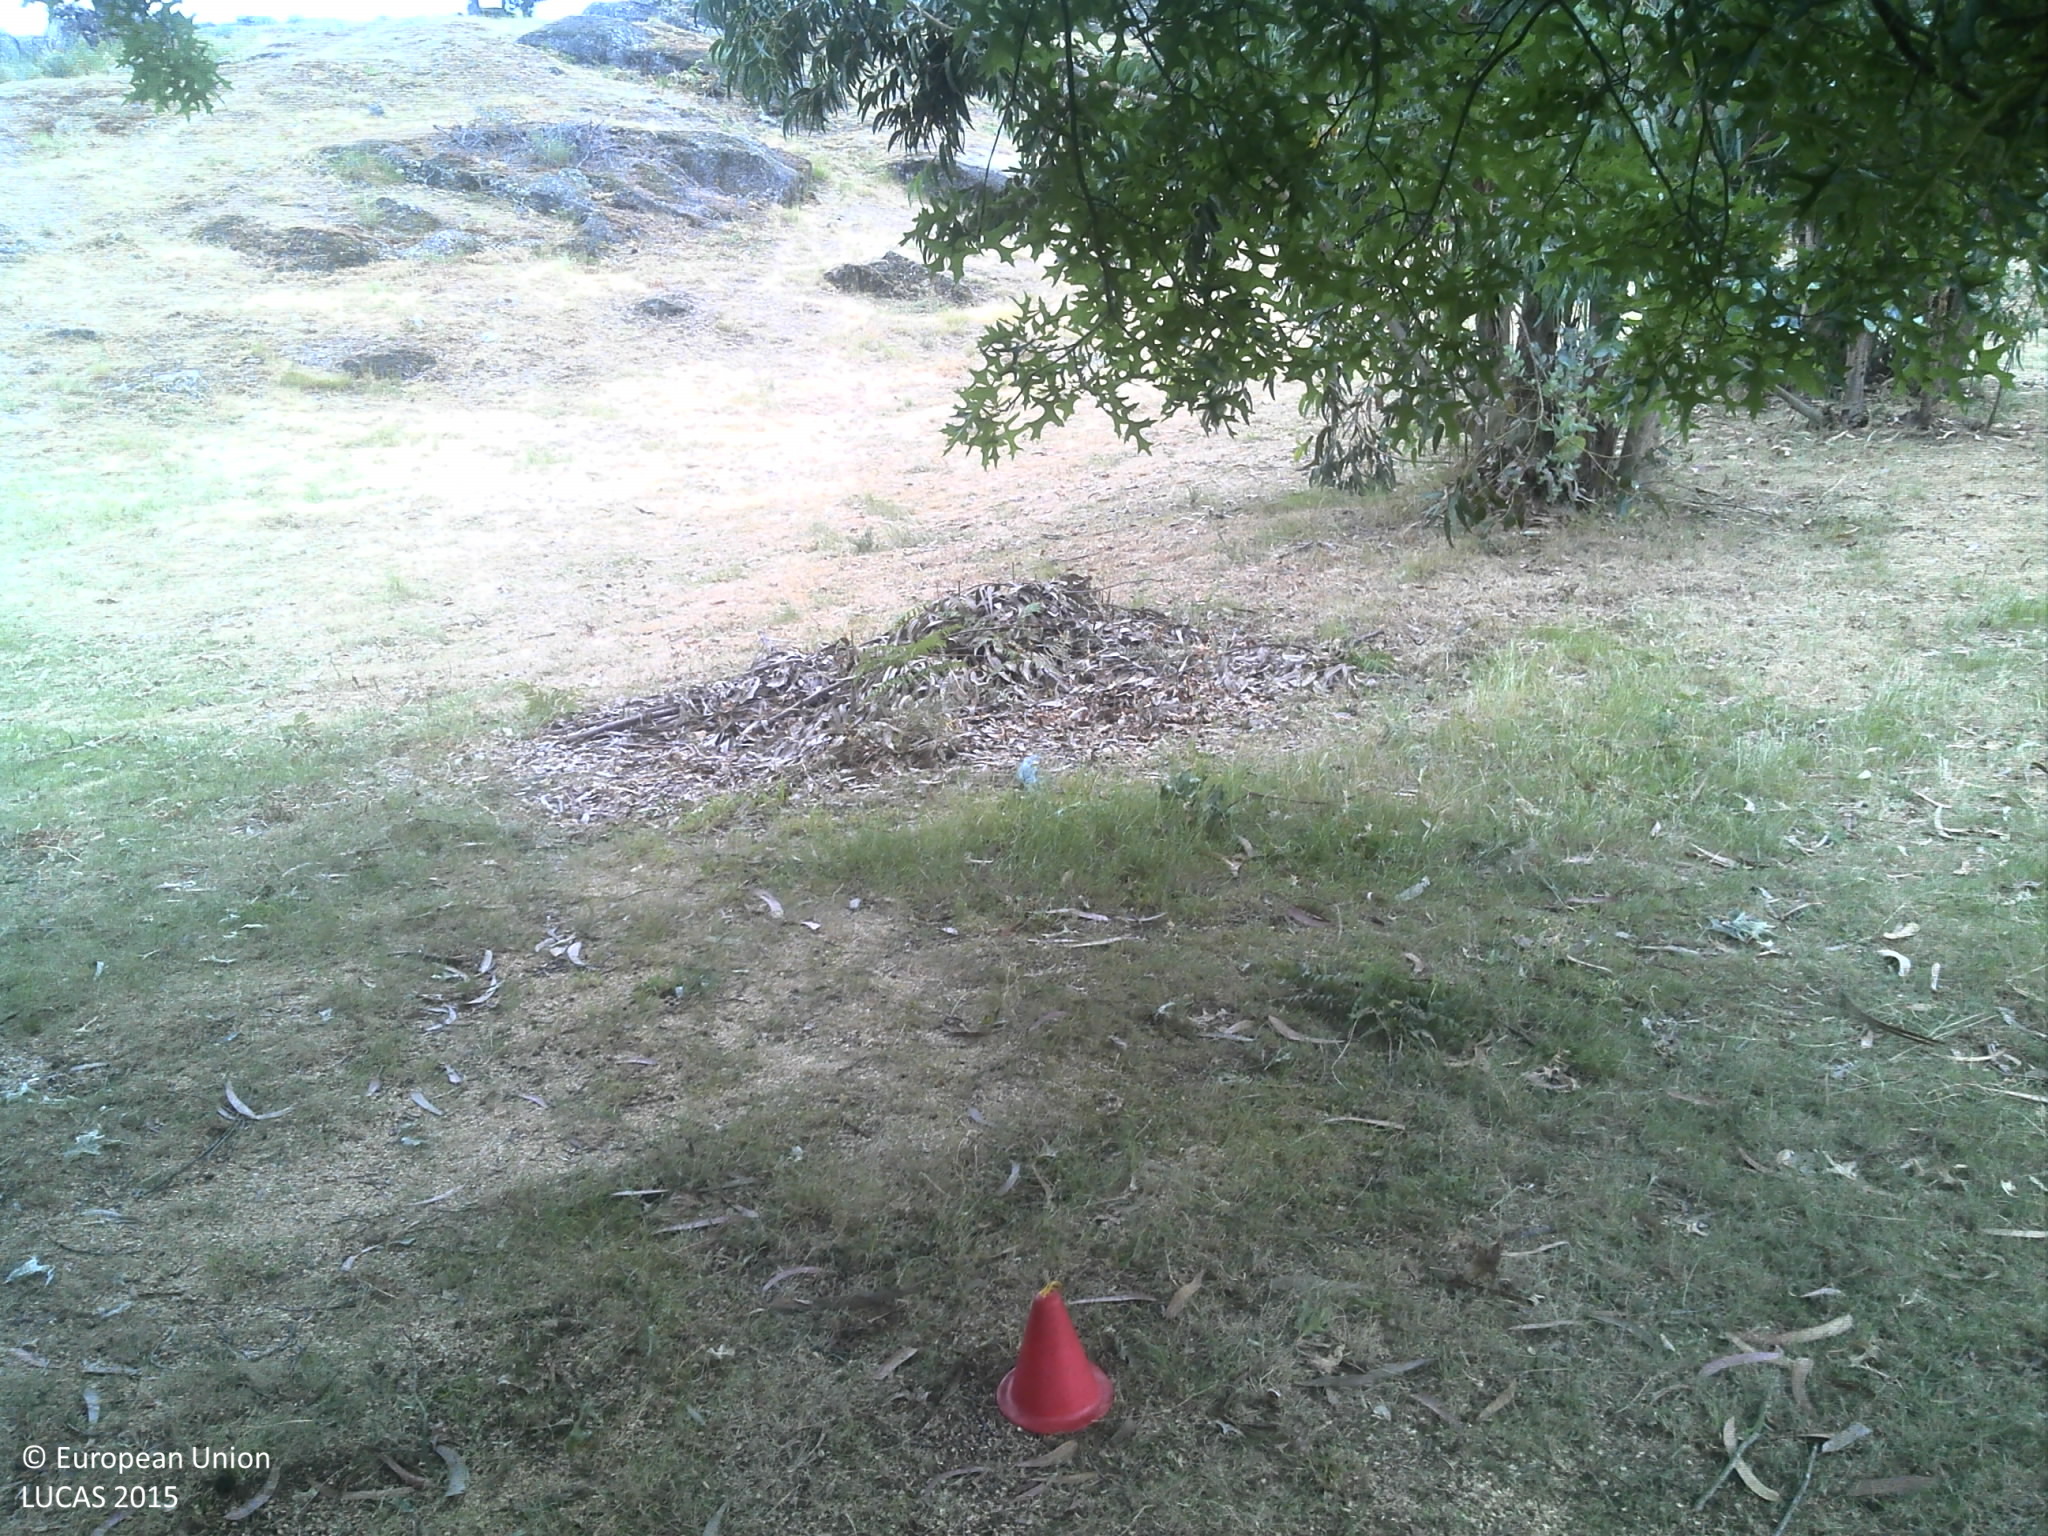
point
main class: Woodland
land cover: Broadleaved woodland
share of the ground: > 75 %
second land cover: Grassland without tree/shrub cover
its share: 10 - 25 %
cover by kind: broadleaved forest trees 75 %, unconsolidated bare surface 15 %, herbaceous plants 10 %
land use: Forestry
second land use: Agriculture (excluding fallow land and kitchen gardens)
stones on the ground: < 10 %
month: June
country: PT
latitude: 41.1602
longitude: -8.1710
